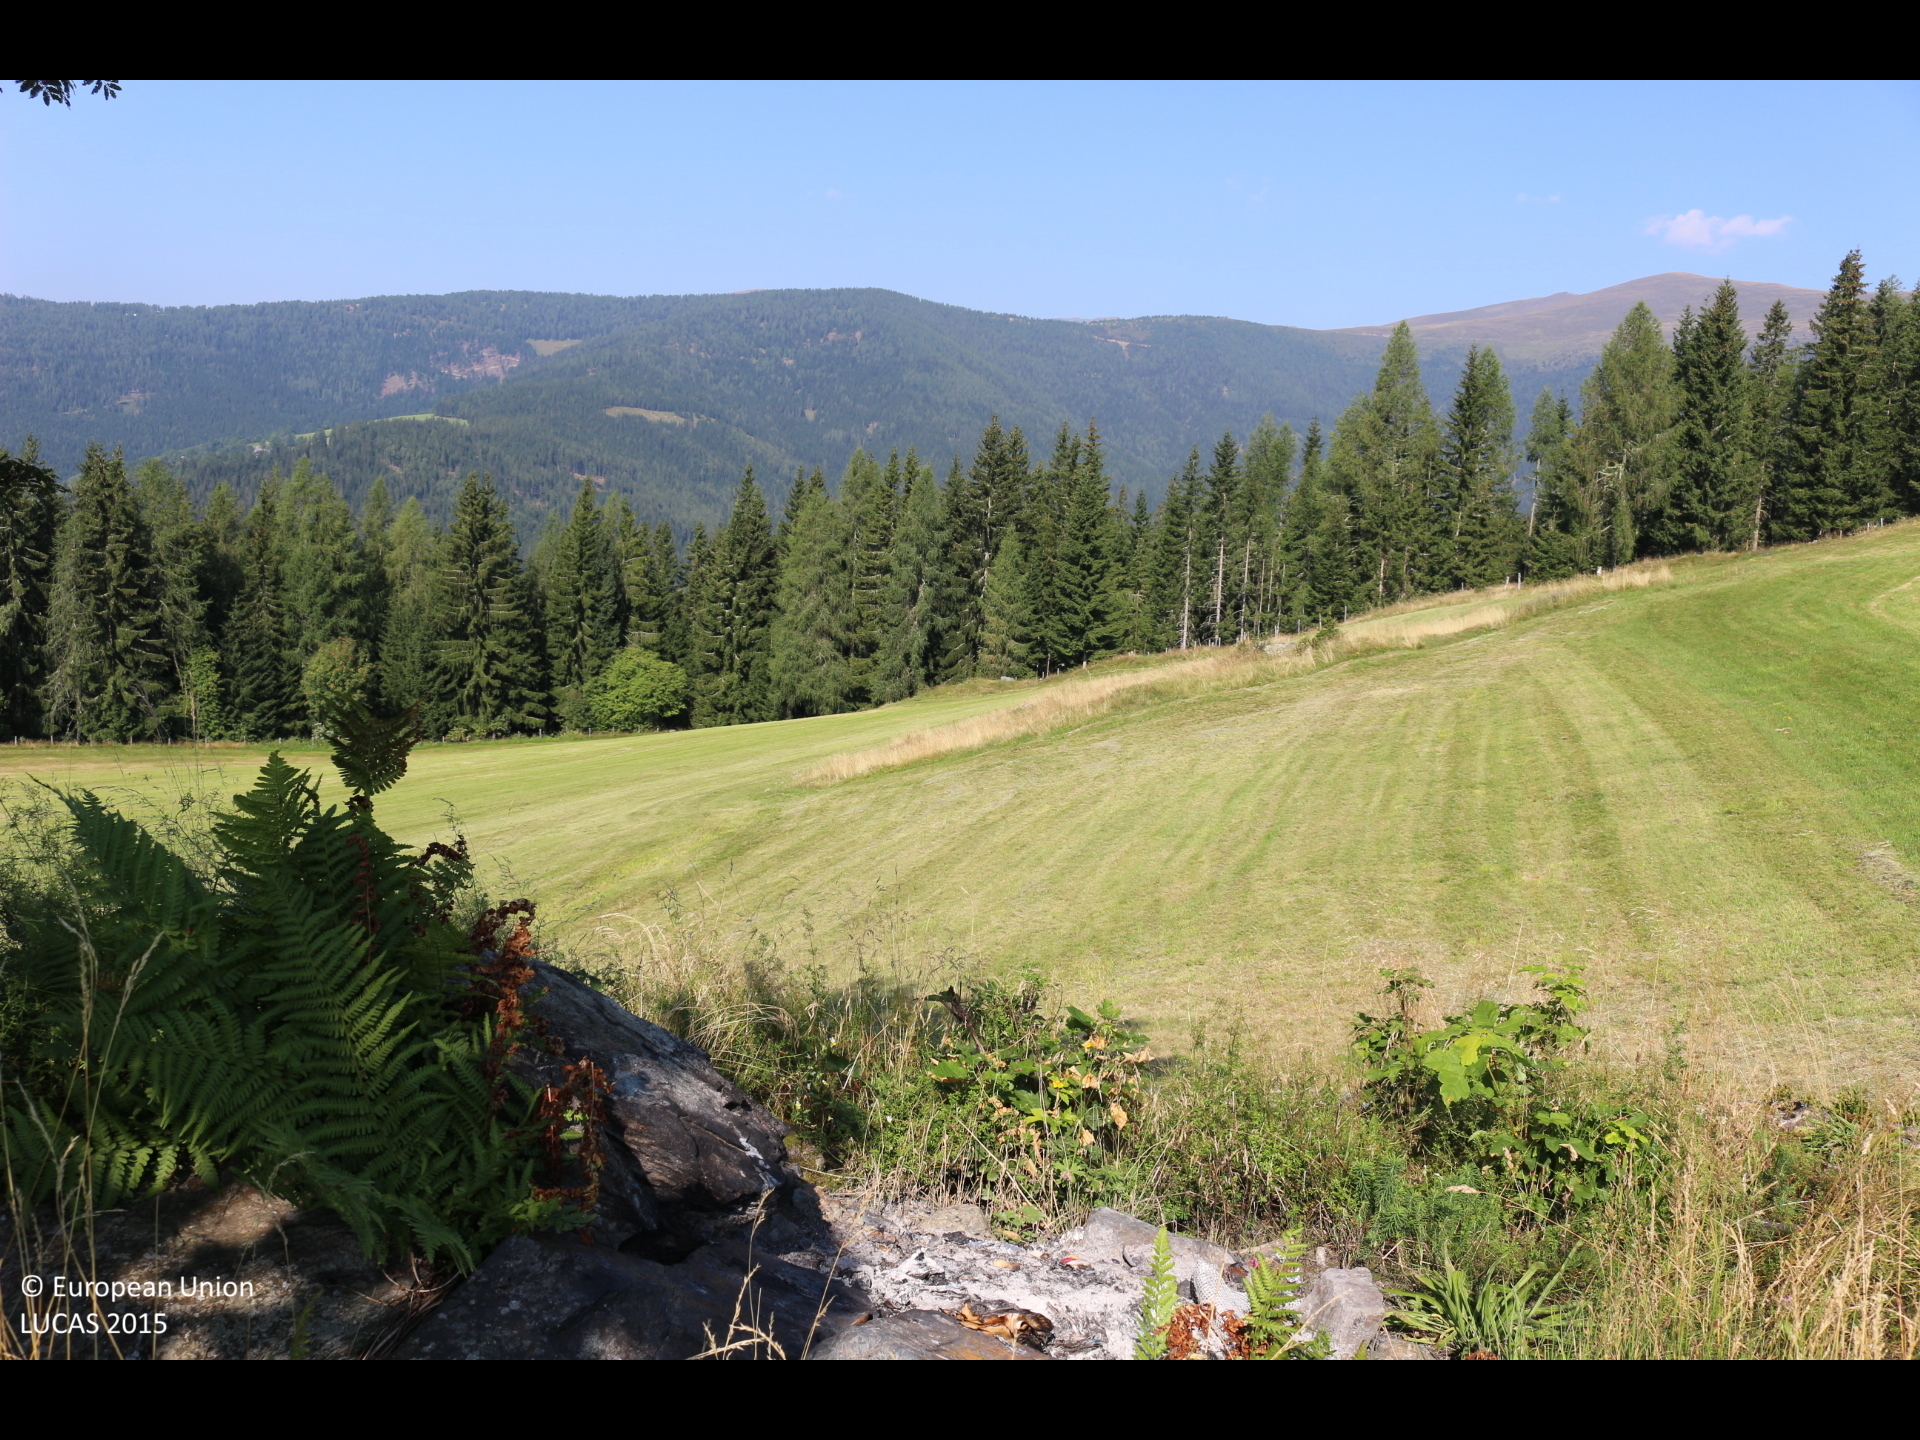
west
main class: Woodland
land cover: Broadleaved woodland
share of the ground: 50 - 75 %
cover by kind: broadleaved forest trees 70 %, herbaceous plants 25 %, consolidated bare surface 5 %
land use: Agriculture (excluding fallow land and kitchen gardens)
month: August
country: AT
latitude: 46.8875
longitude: 14.0530
